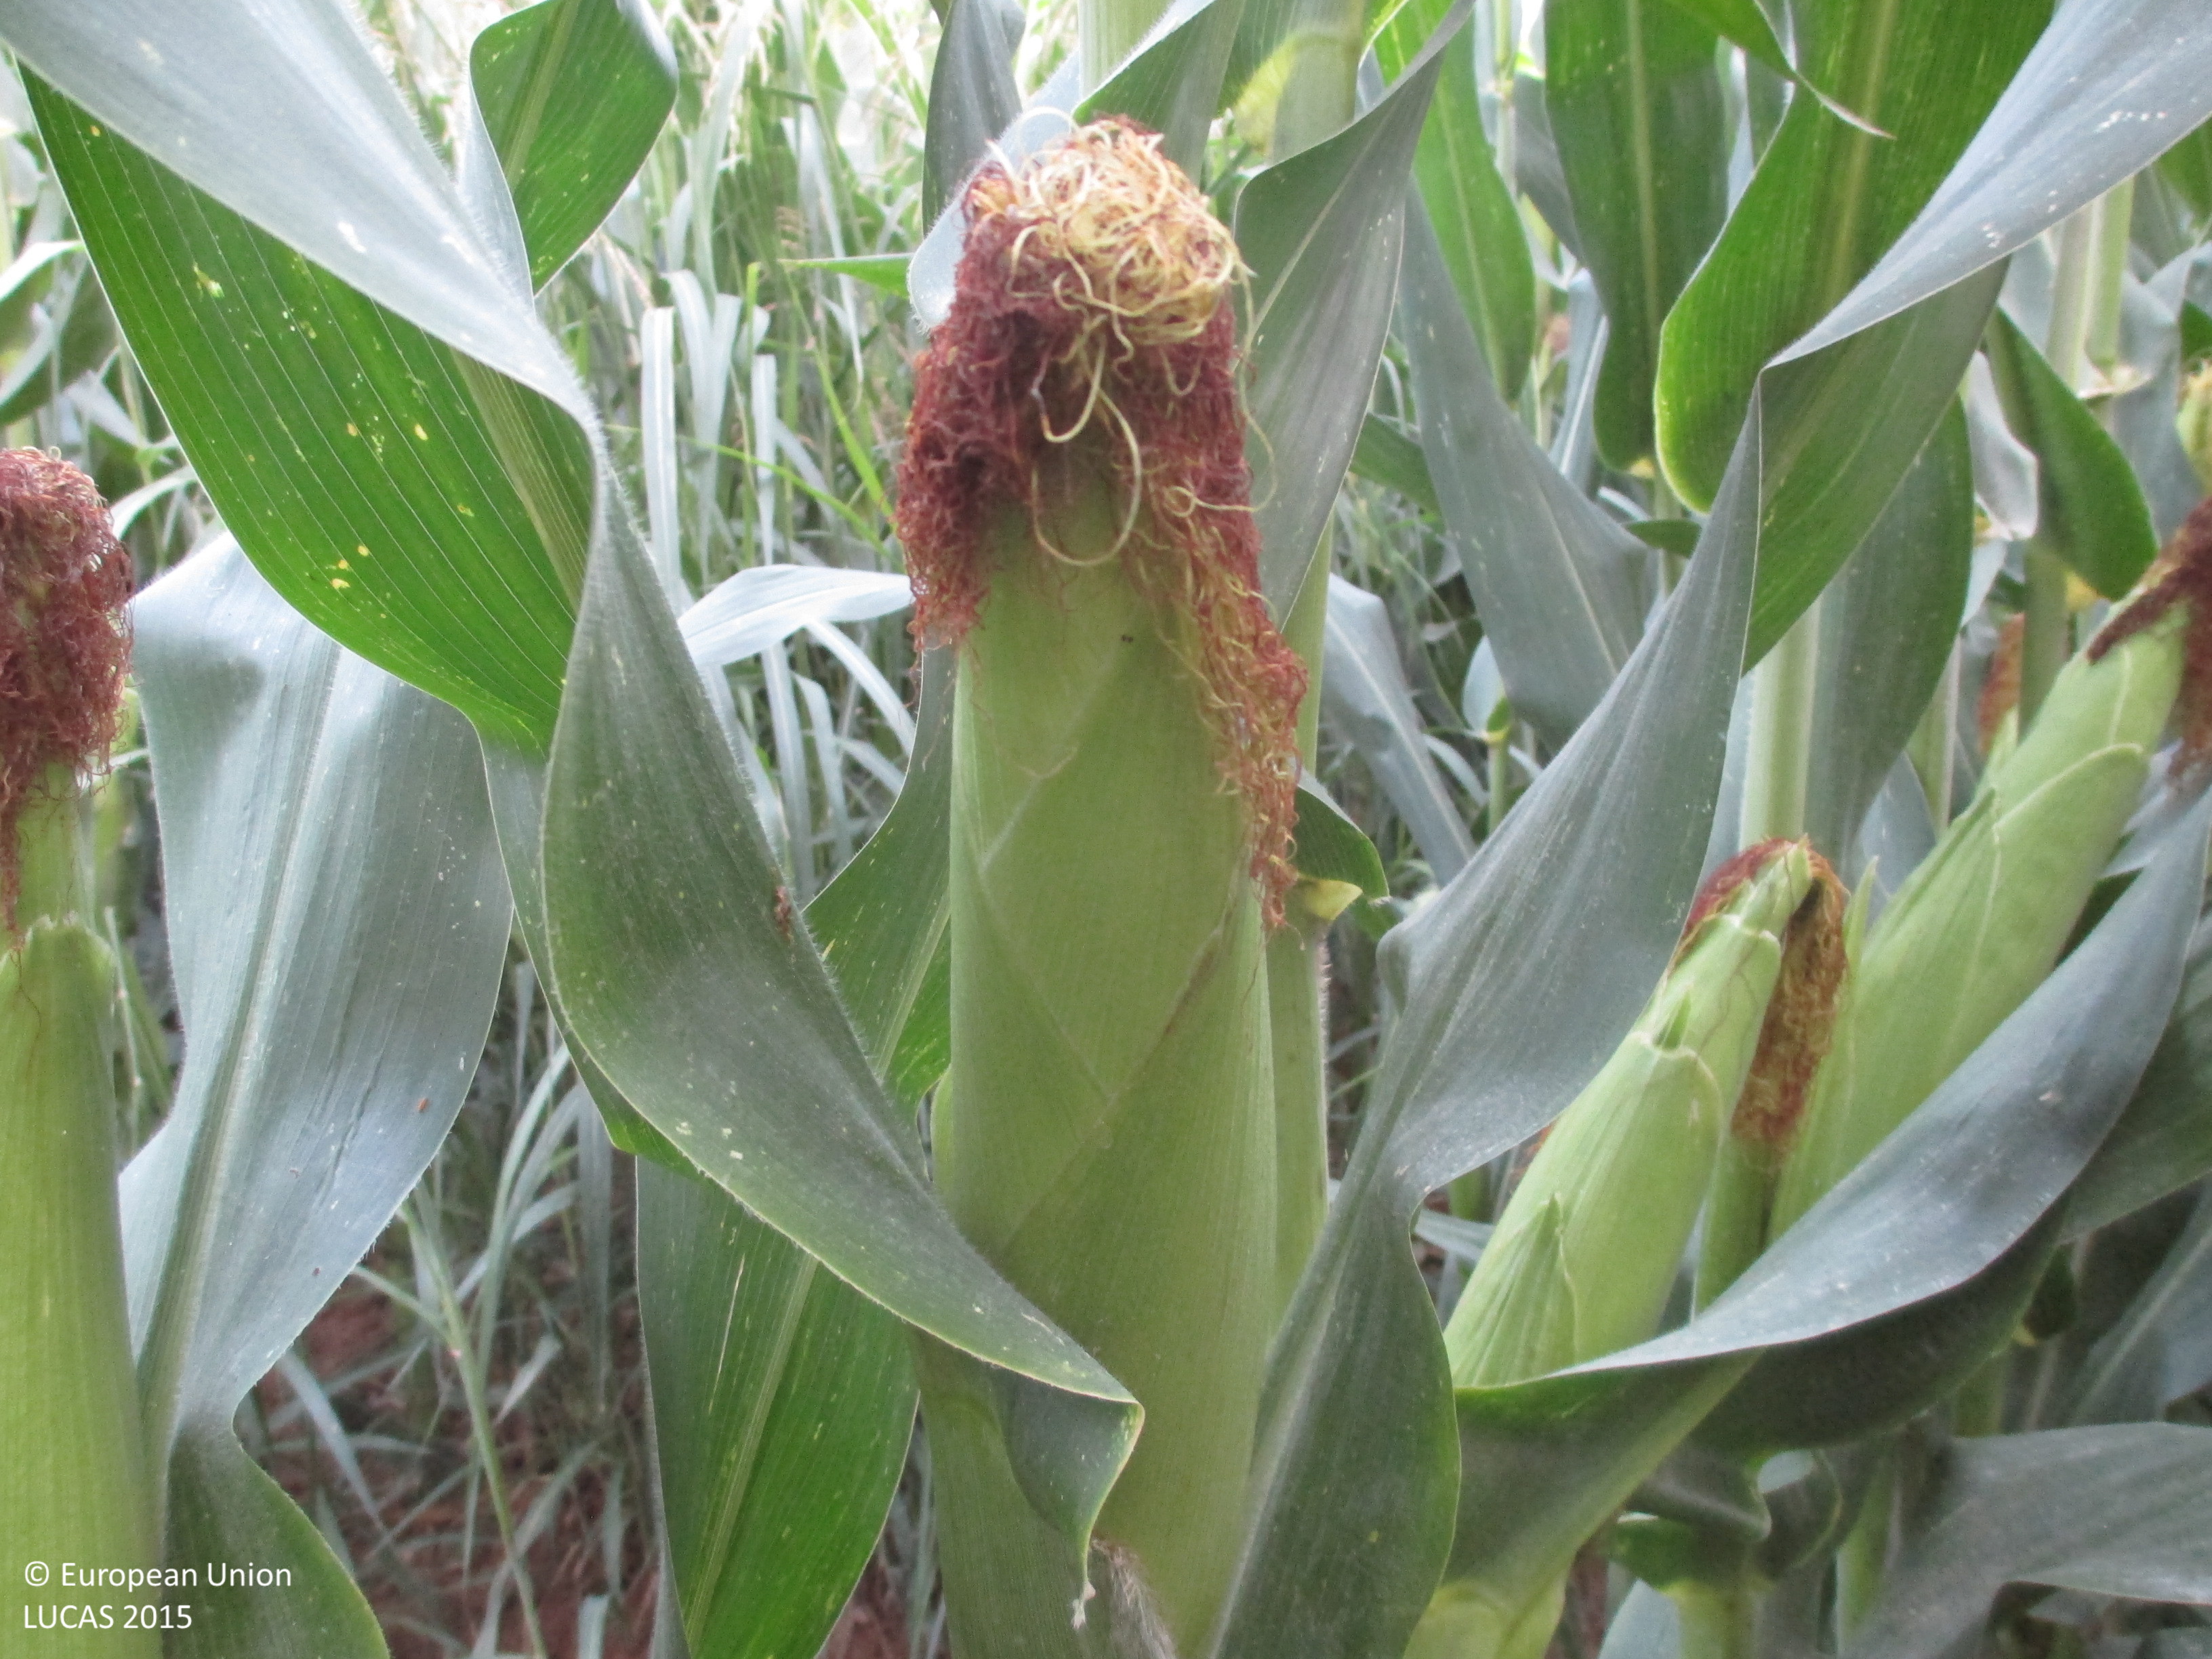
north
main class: Cropland
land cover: Maize
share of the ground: > 75 %
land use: Agriculture (excluding fallow land and kitchen gardens)
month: July
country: ES
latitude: 41.8456
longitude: 0.3374
